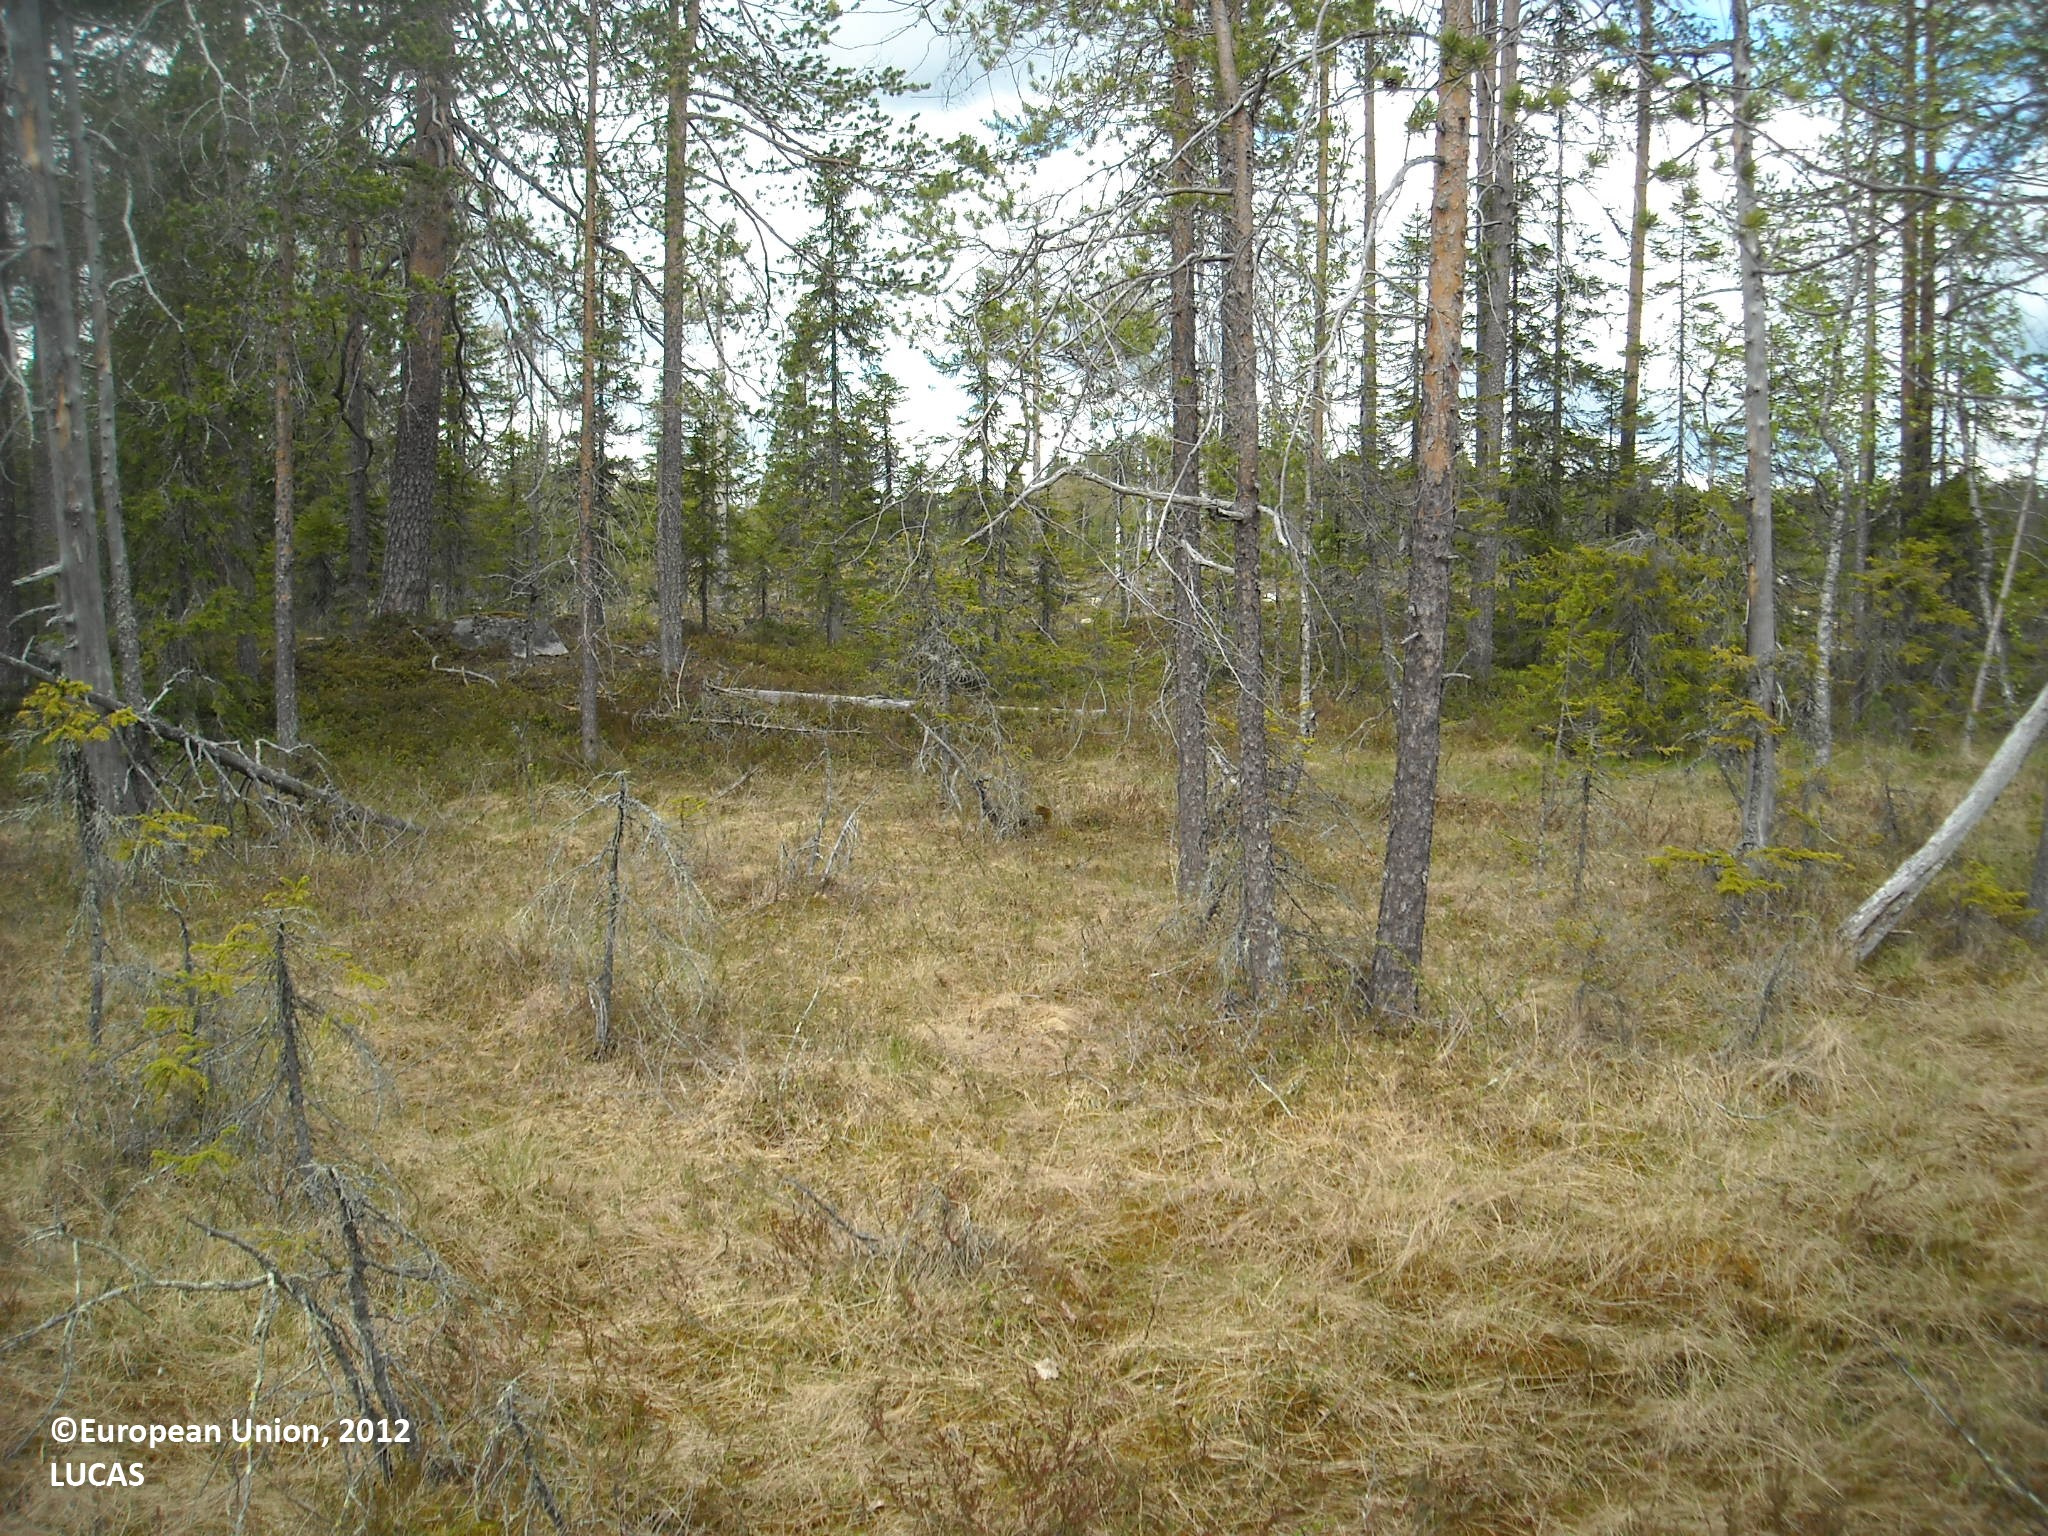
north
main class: Woodland
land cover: Pine dominated coniferous woodland
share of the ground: 25 - 50 %
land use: Semi-natural and natural areas not in use
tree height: > 5 m
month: June
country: FI
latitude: 65.3385
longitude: 27.7741
